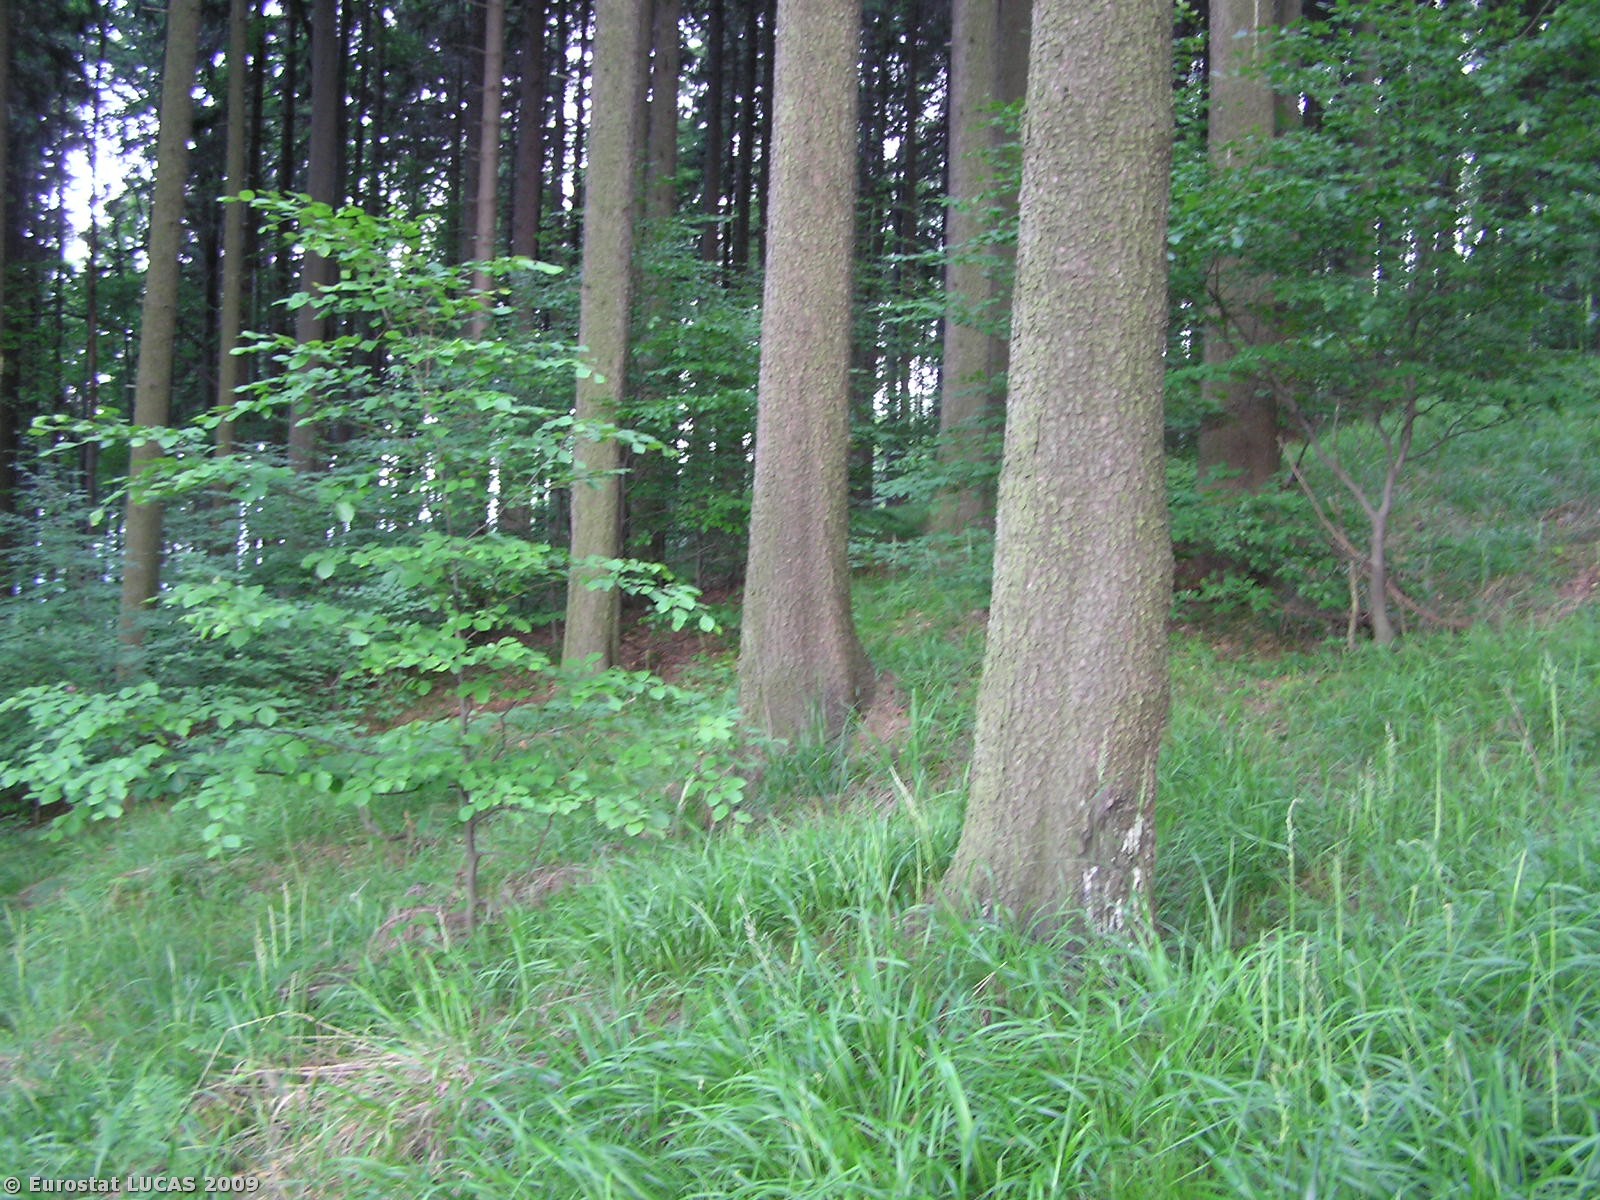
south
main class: Woodland
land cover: Mixed woodland
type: hemiboreal forest and nemoral coniferous forest and mixed broadleaved-coniferous forest
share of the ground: > 75 %
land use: Forestry
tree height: > 5 m
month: July
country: CZ
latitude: 50.2326
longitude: 17.4000
